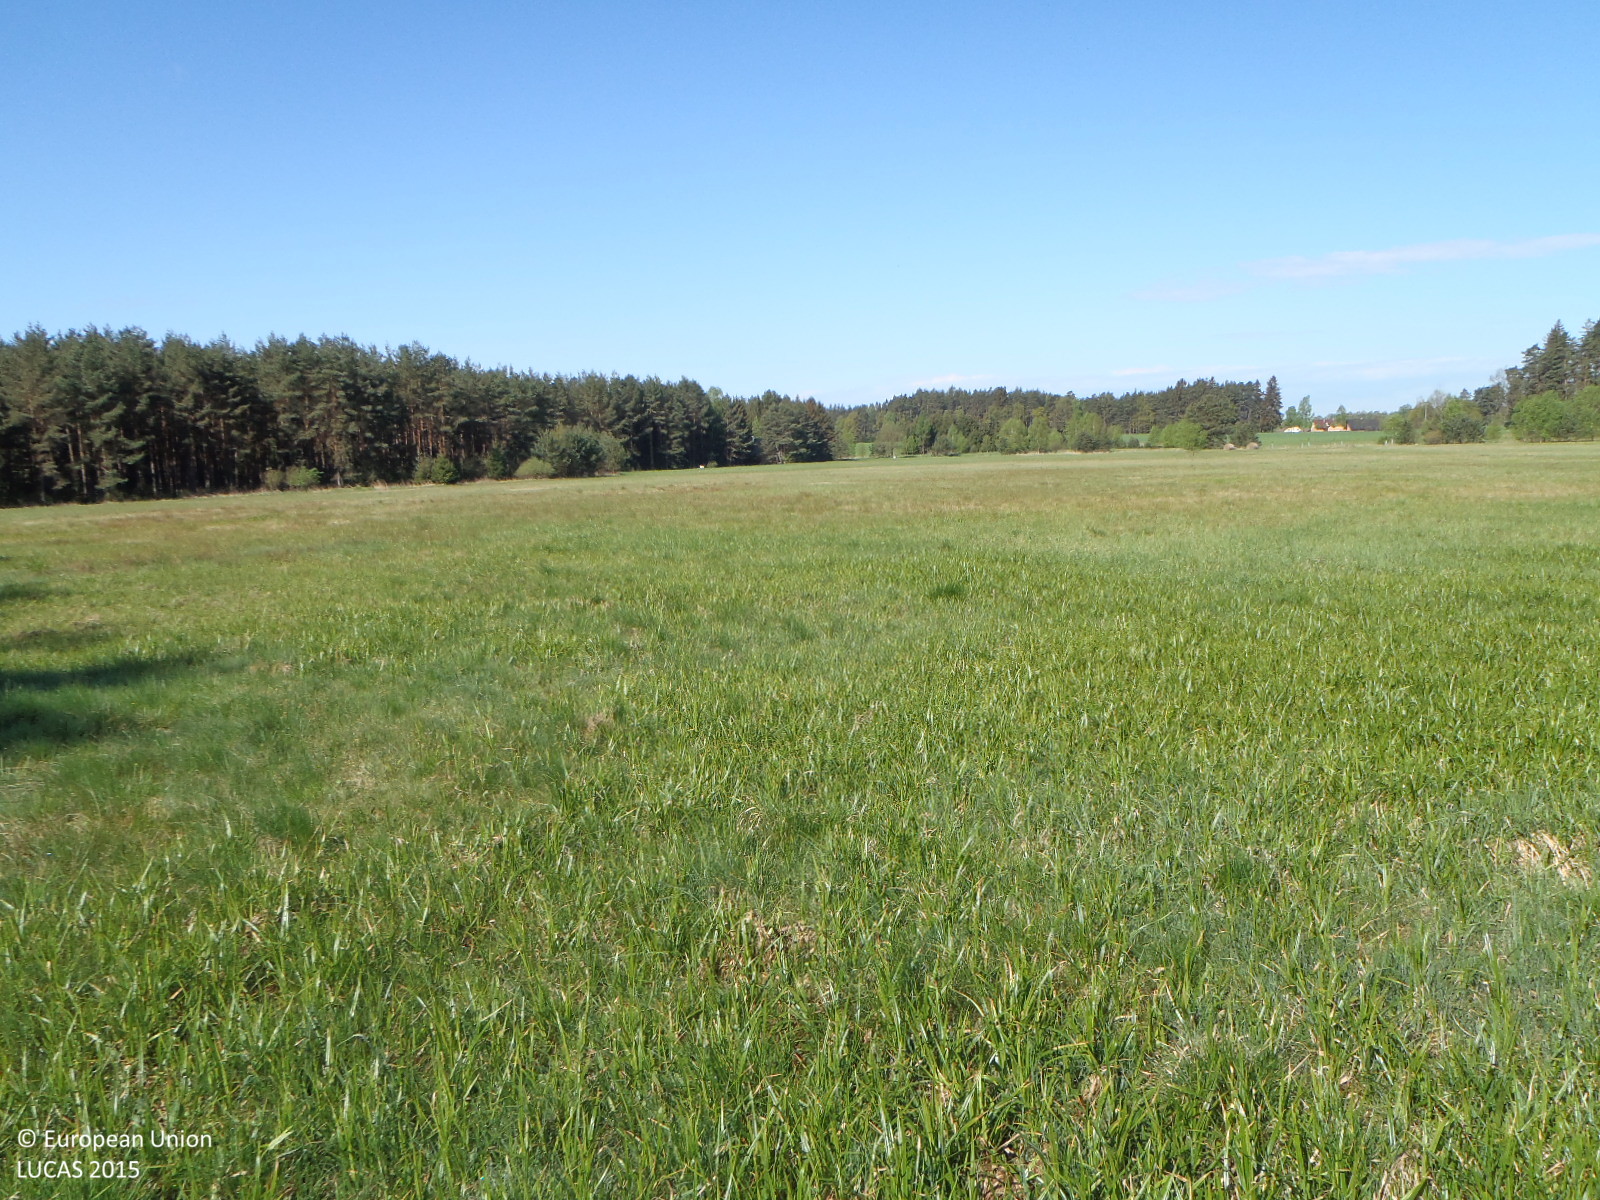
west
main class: Grassland
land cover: Grassland without tree/shrub cover
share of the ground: > 75 %
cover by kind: herbaceous plants 100 %
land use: Agriculture (excluding fallow land and kitchen gardens)
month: May
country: CZ
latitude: 49.0990
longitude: 15.0562
